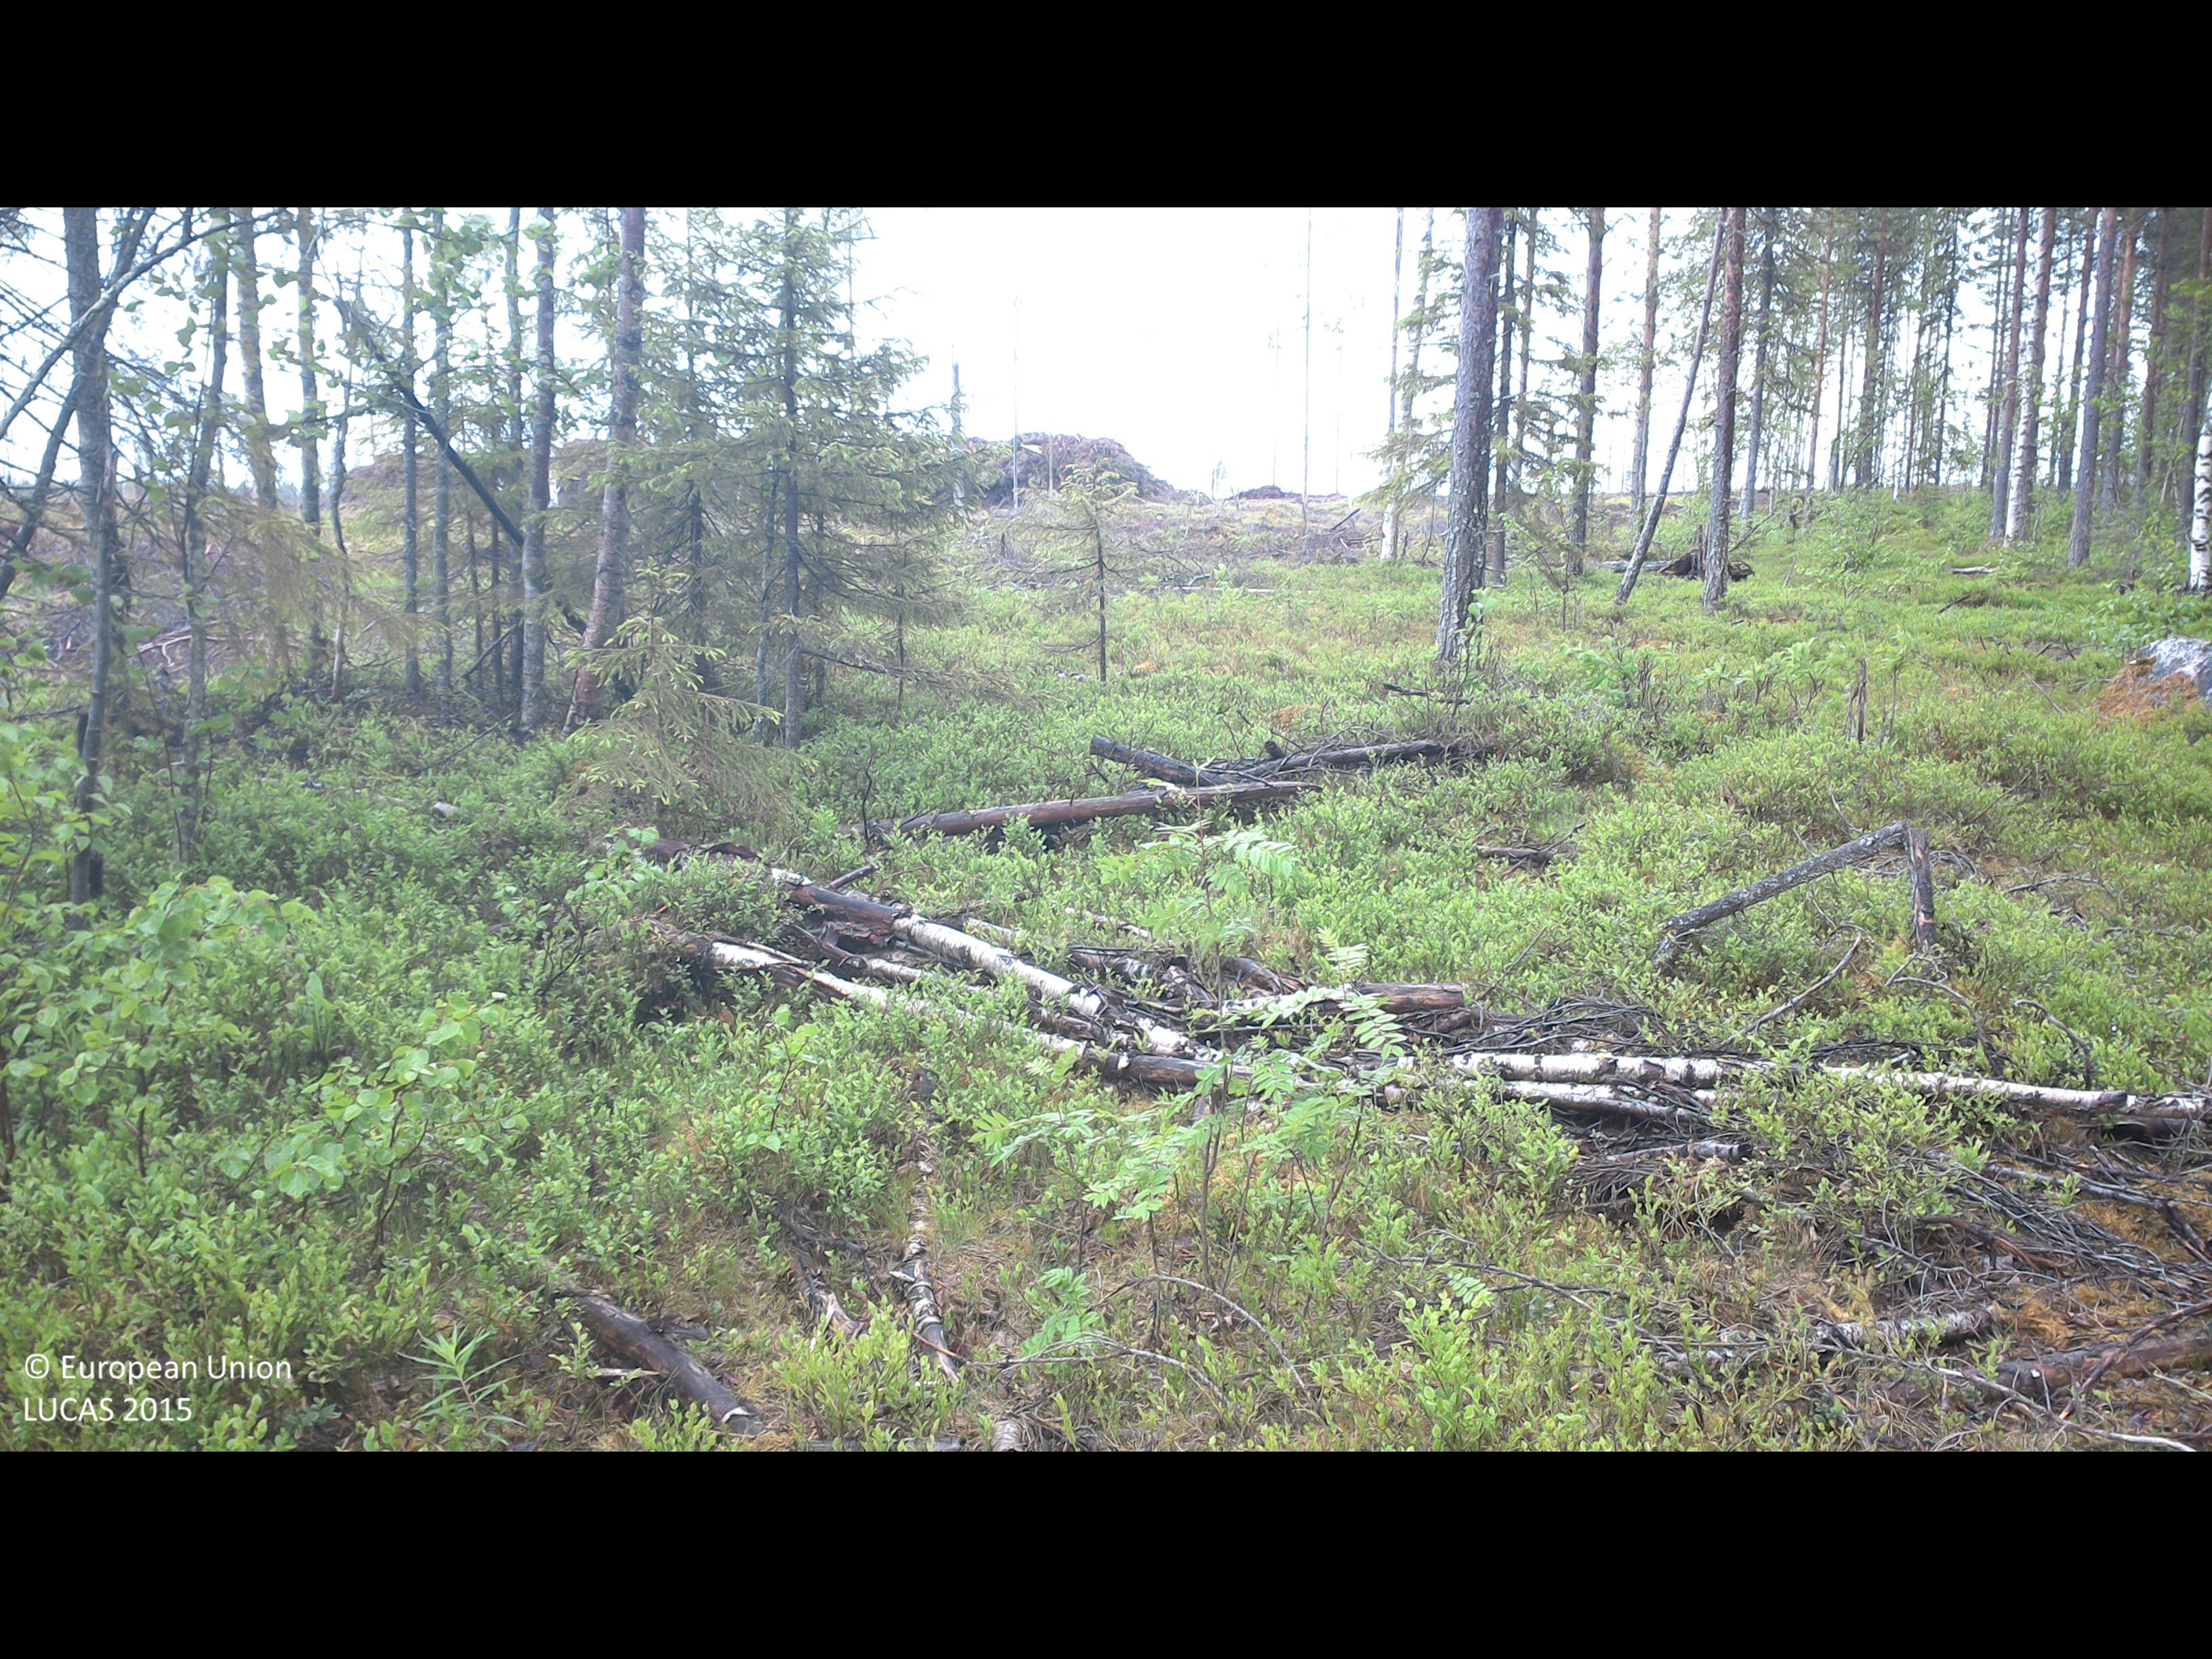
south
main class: Woodland
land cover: Pine dominated mixed woodland
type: boreal forest
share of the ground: 25 - 50 %
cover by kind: shrubs 70 %, coniferous forest trees 20 %, broadleaved forest trees 10 %
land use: Forestry
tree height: > 5 m
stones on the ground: < 10 %
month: June
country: SE
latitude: 66.8909
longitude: 22.5475
